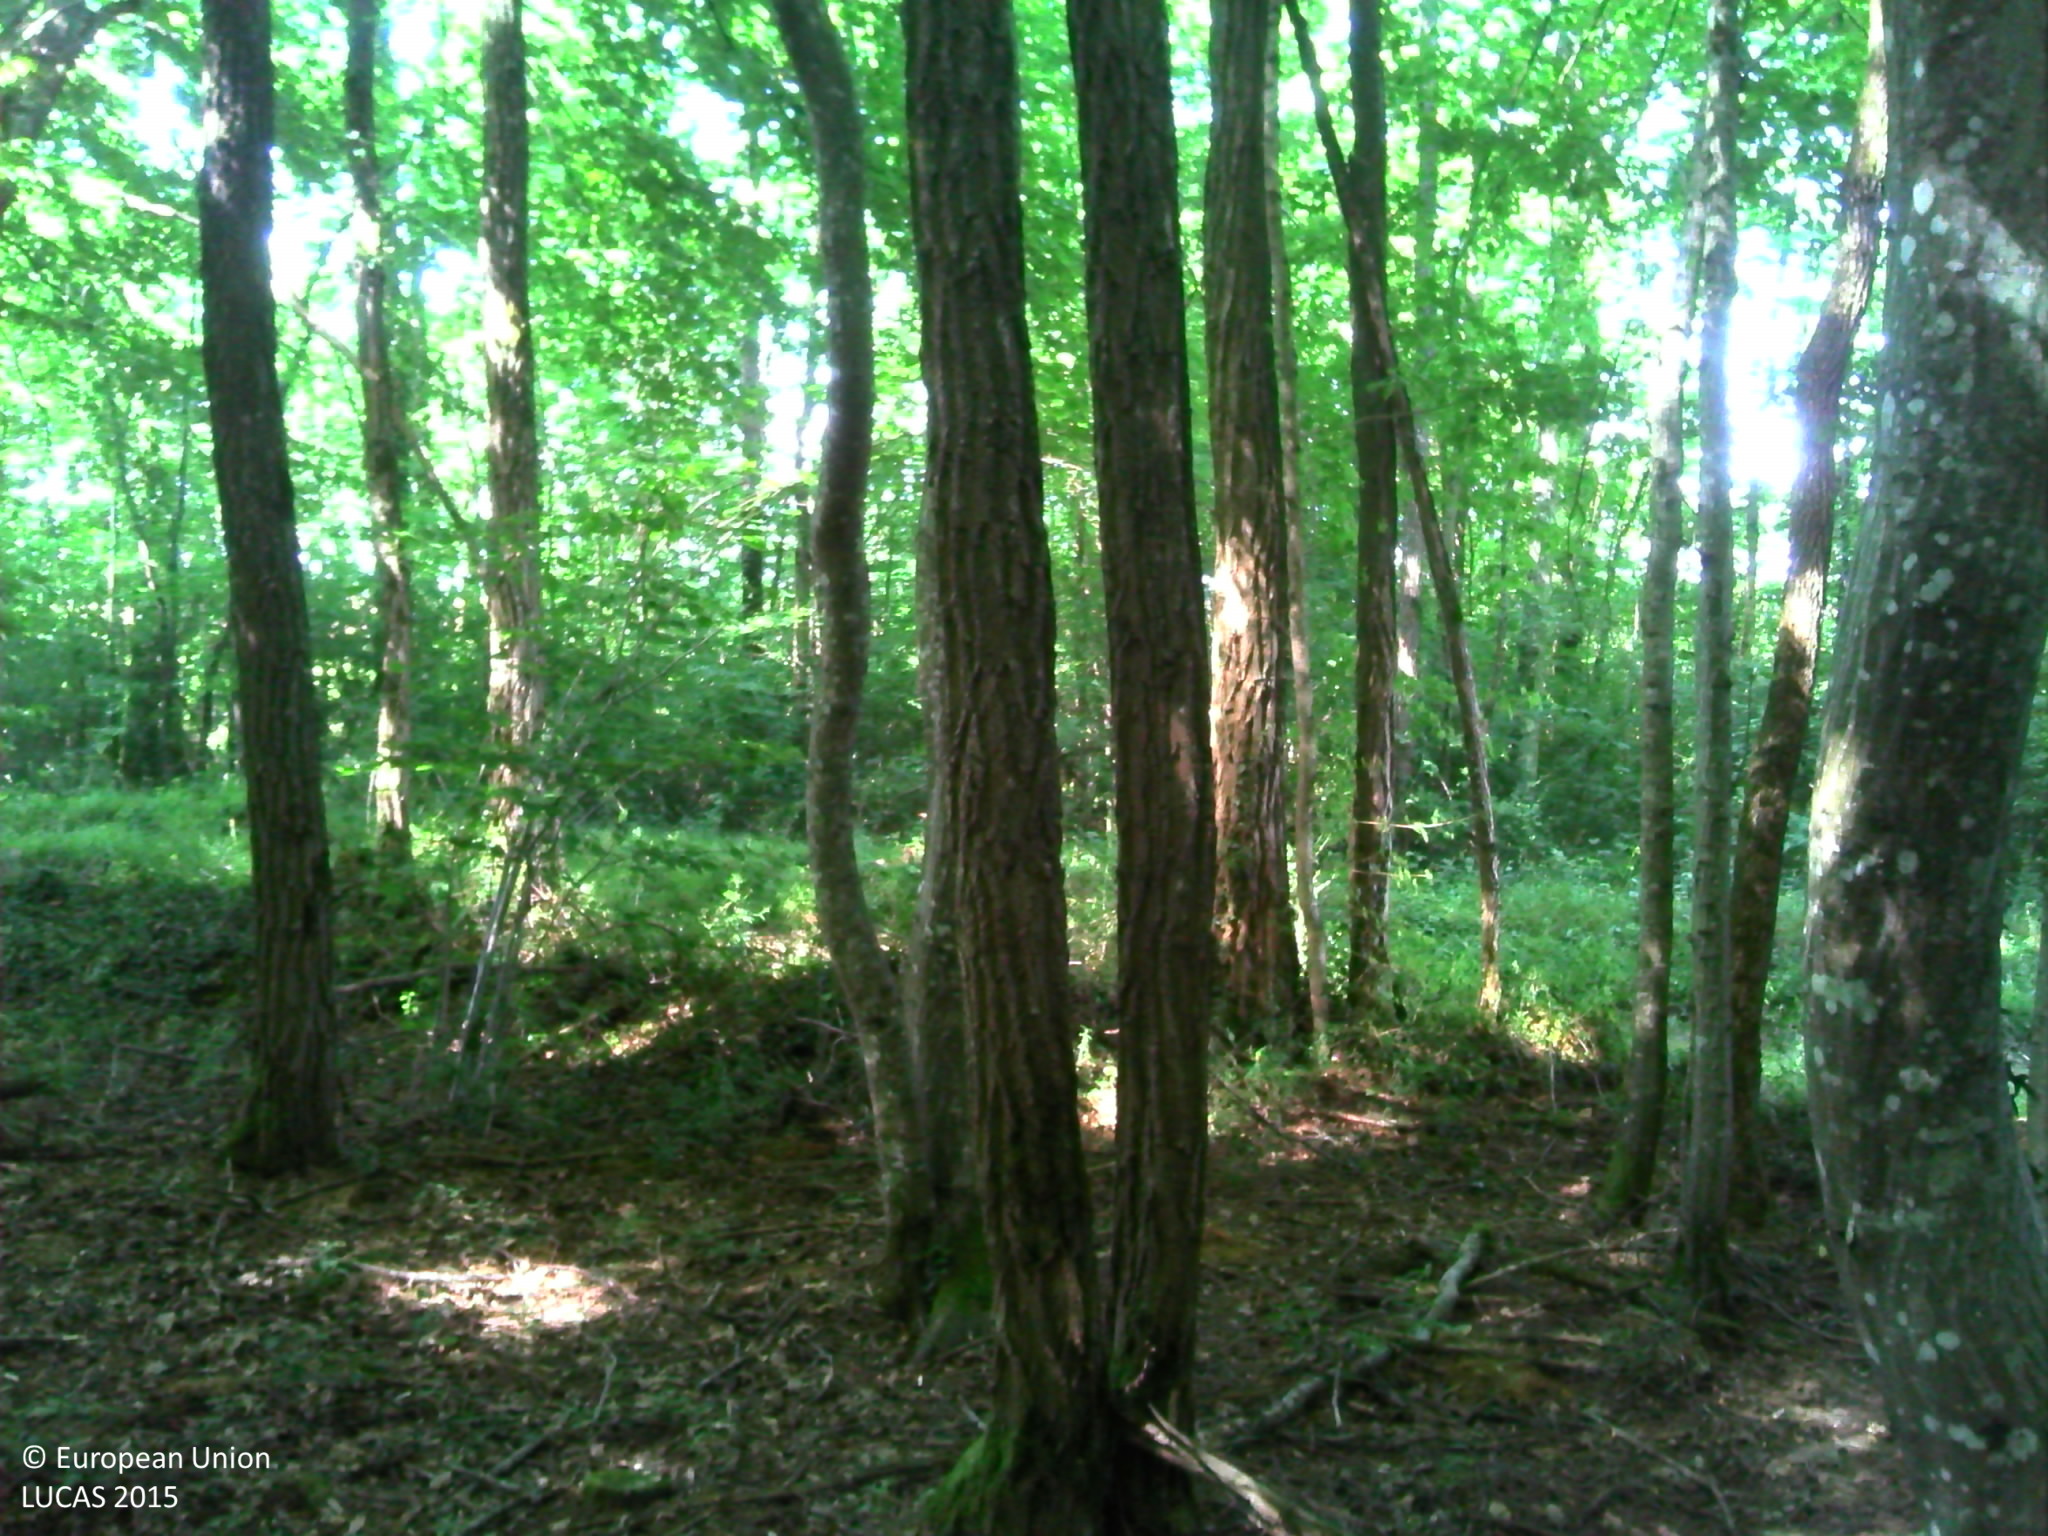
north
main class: Woodland
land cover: Broadleaved woodland
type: mesophytic deciduous forest
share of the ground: > 75 %
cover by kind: broadleaved forest trees 100 %
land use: Forestry
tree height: > 5 m
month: June
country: FR
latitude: 47.4904
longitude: 3.5058
